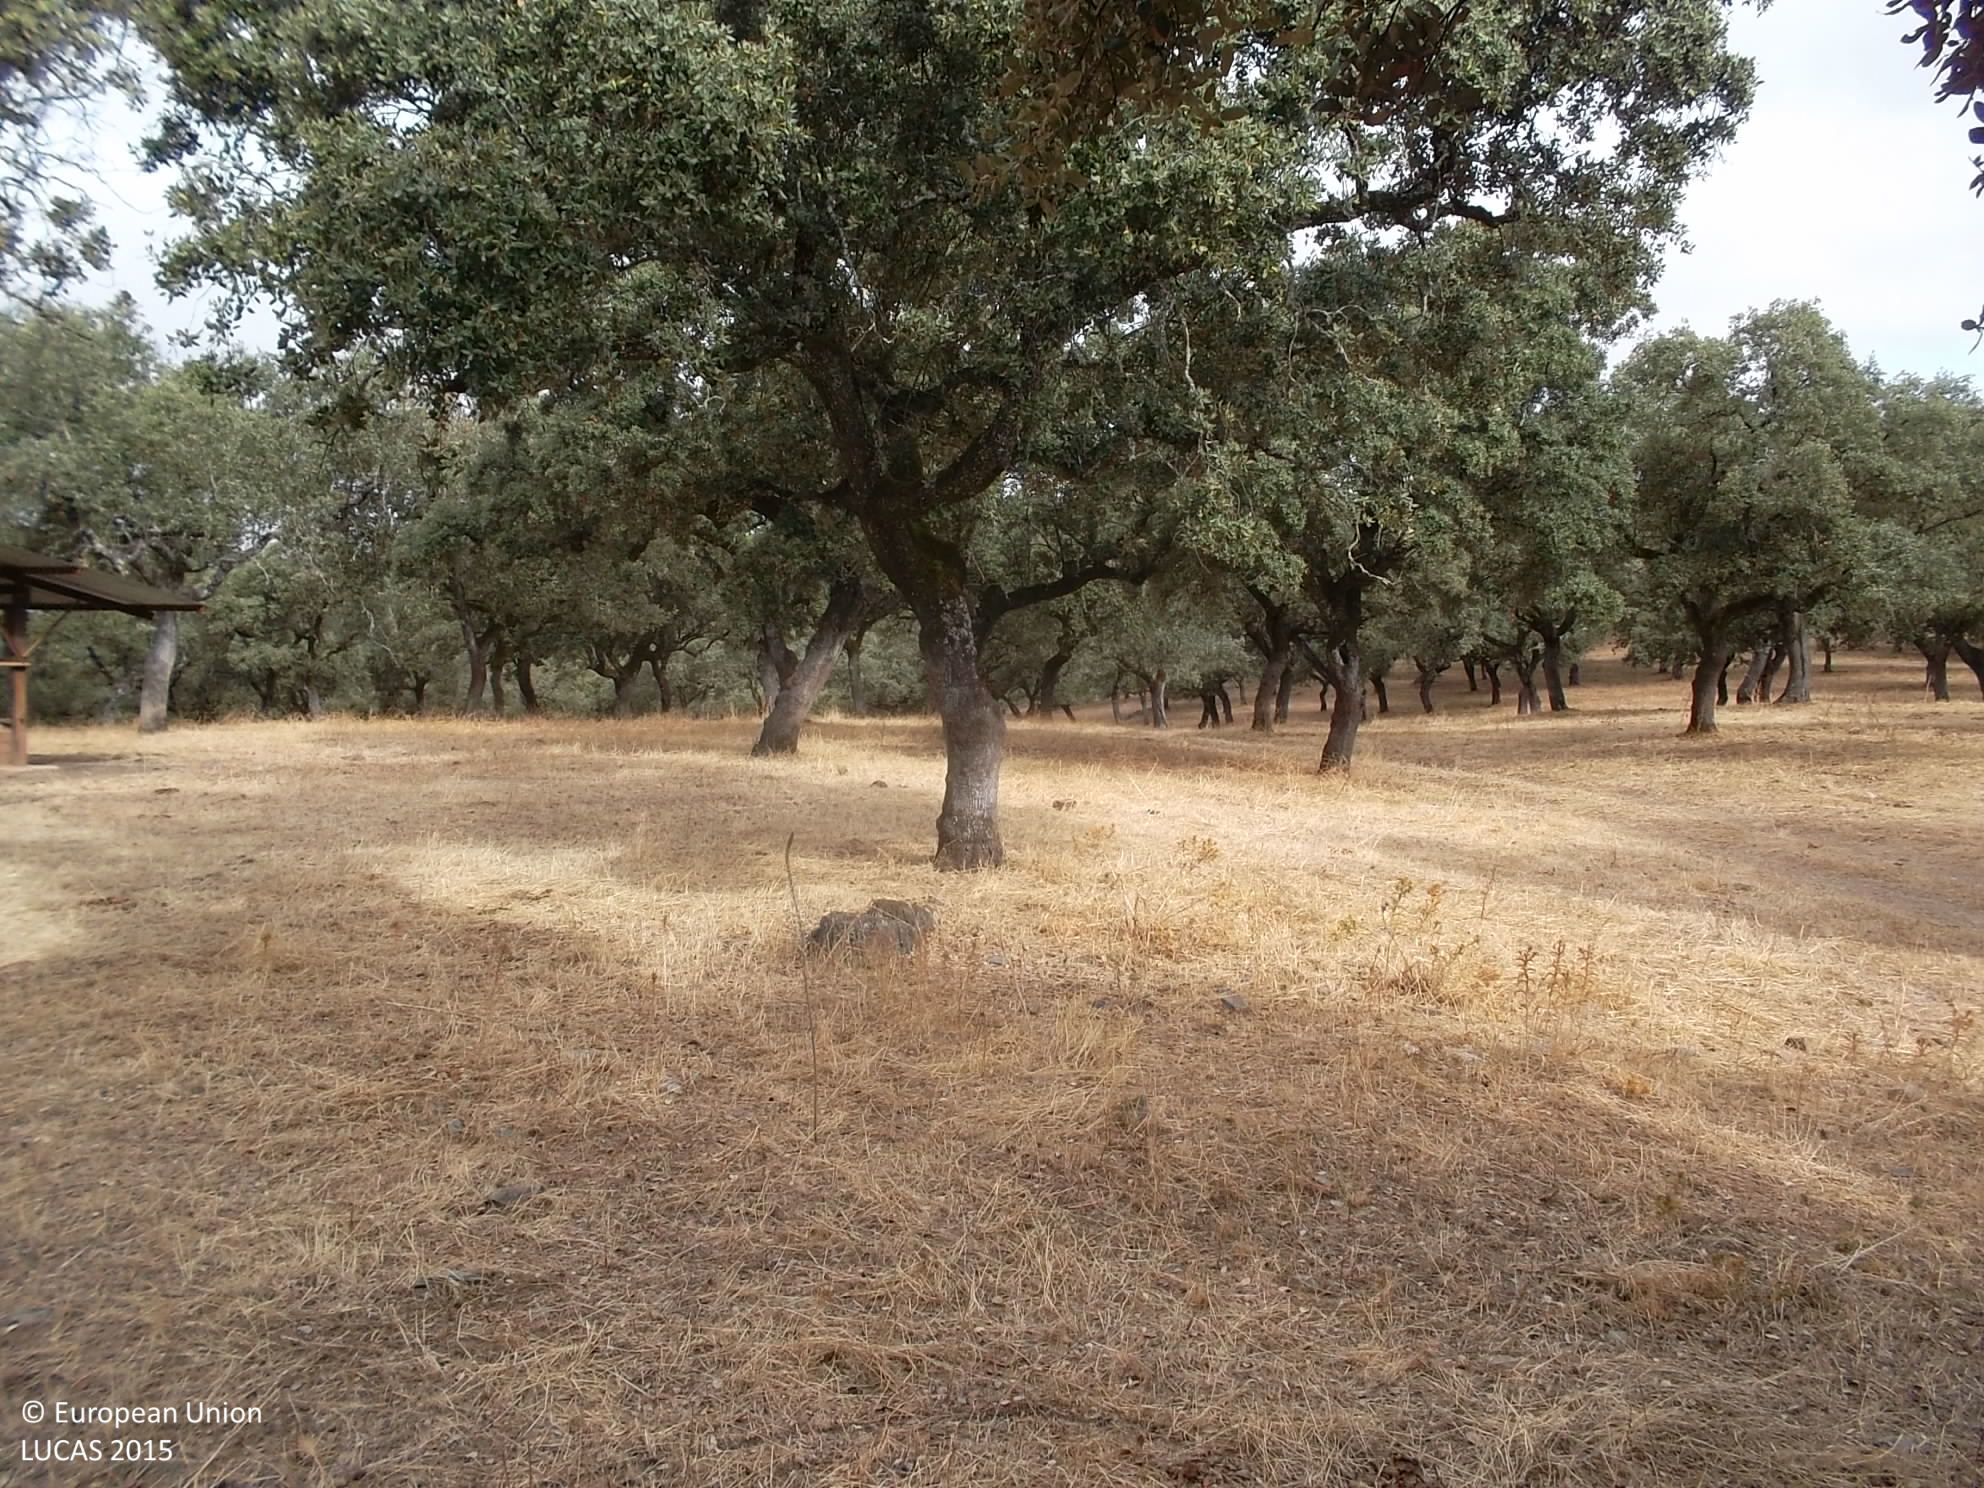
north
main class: Woodland
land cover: Broadleaved woodland
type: broadleaved evergreen forest
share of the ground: 50 - 75 %
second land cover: Grassland without tree/shrub cover
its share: > 75 %
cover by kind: broadleaved forest trees 60 %, herbaceous plants 40 %
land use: Forestry
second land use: Agriculture (excluding fallow land and kitchen gardens)
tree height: > 5 m
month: September
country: ES
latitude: 38.0856
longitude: -6.4977
